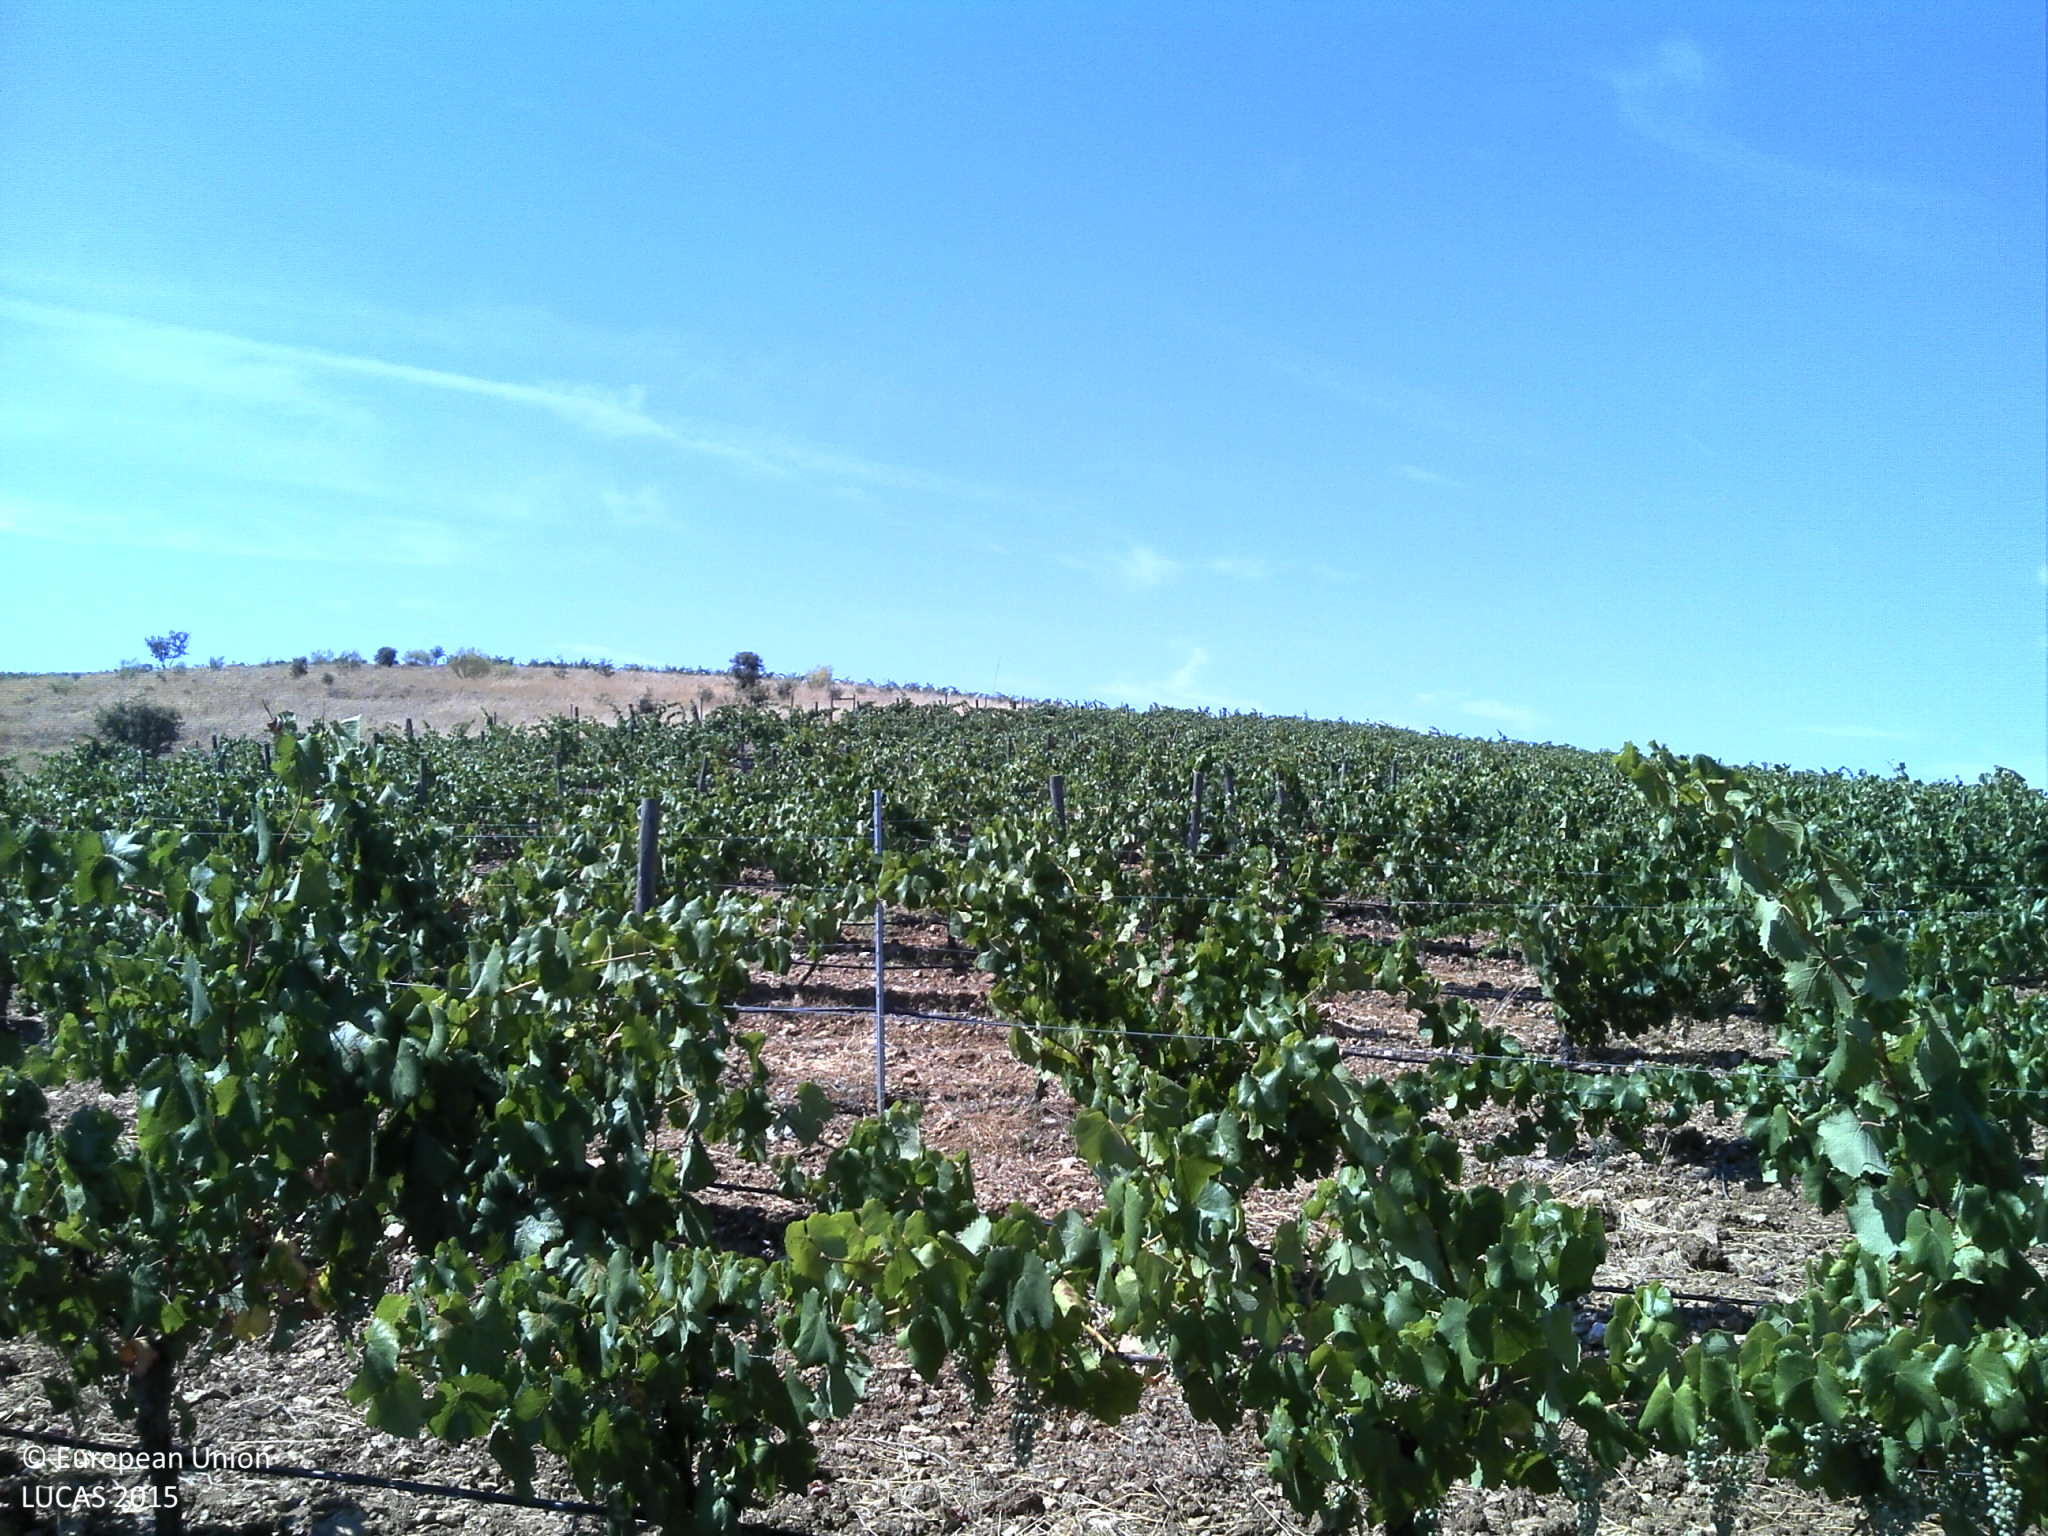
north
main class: Cropland
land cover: Vineyards
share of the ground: 25 - 50 %
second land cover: Other bare soil
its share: > 75 %
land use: Agriculture (excluding fallow land and kitchen gardens)
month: July
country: PT
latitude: 38.4291
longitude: -7.6604
